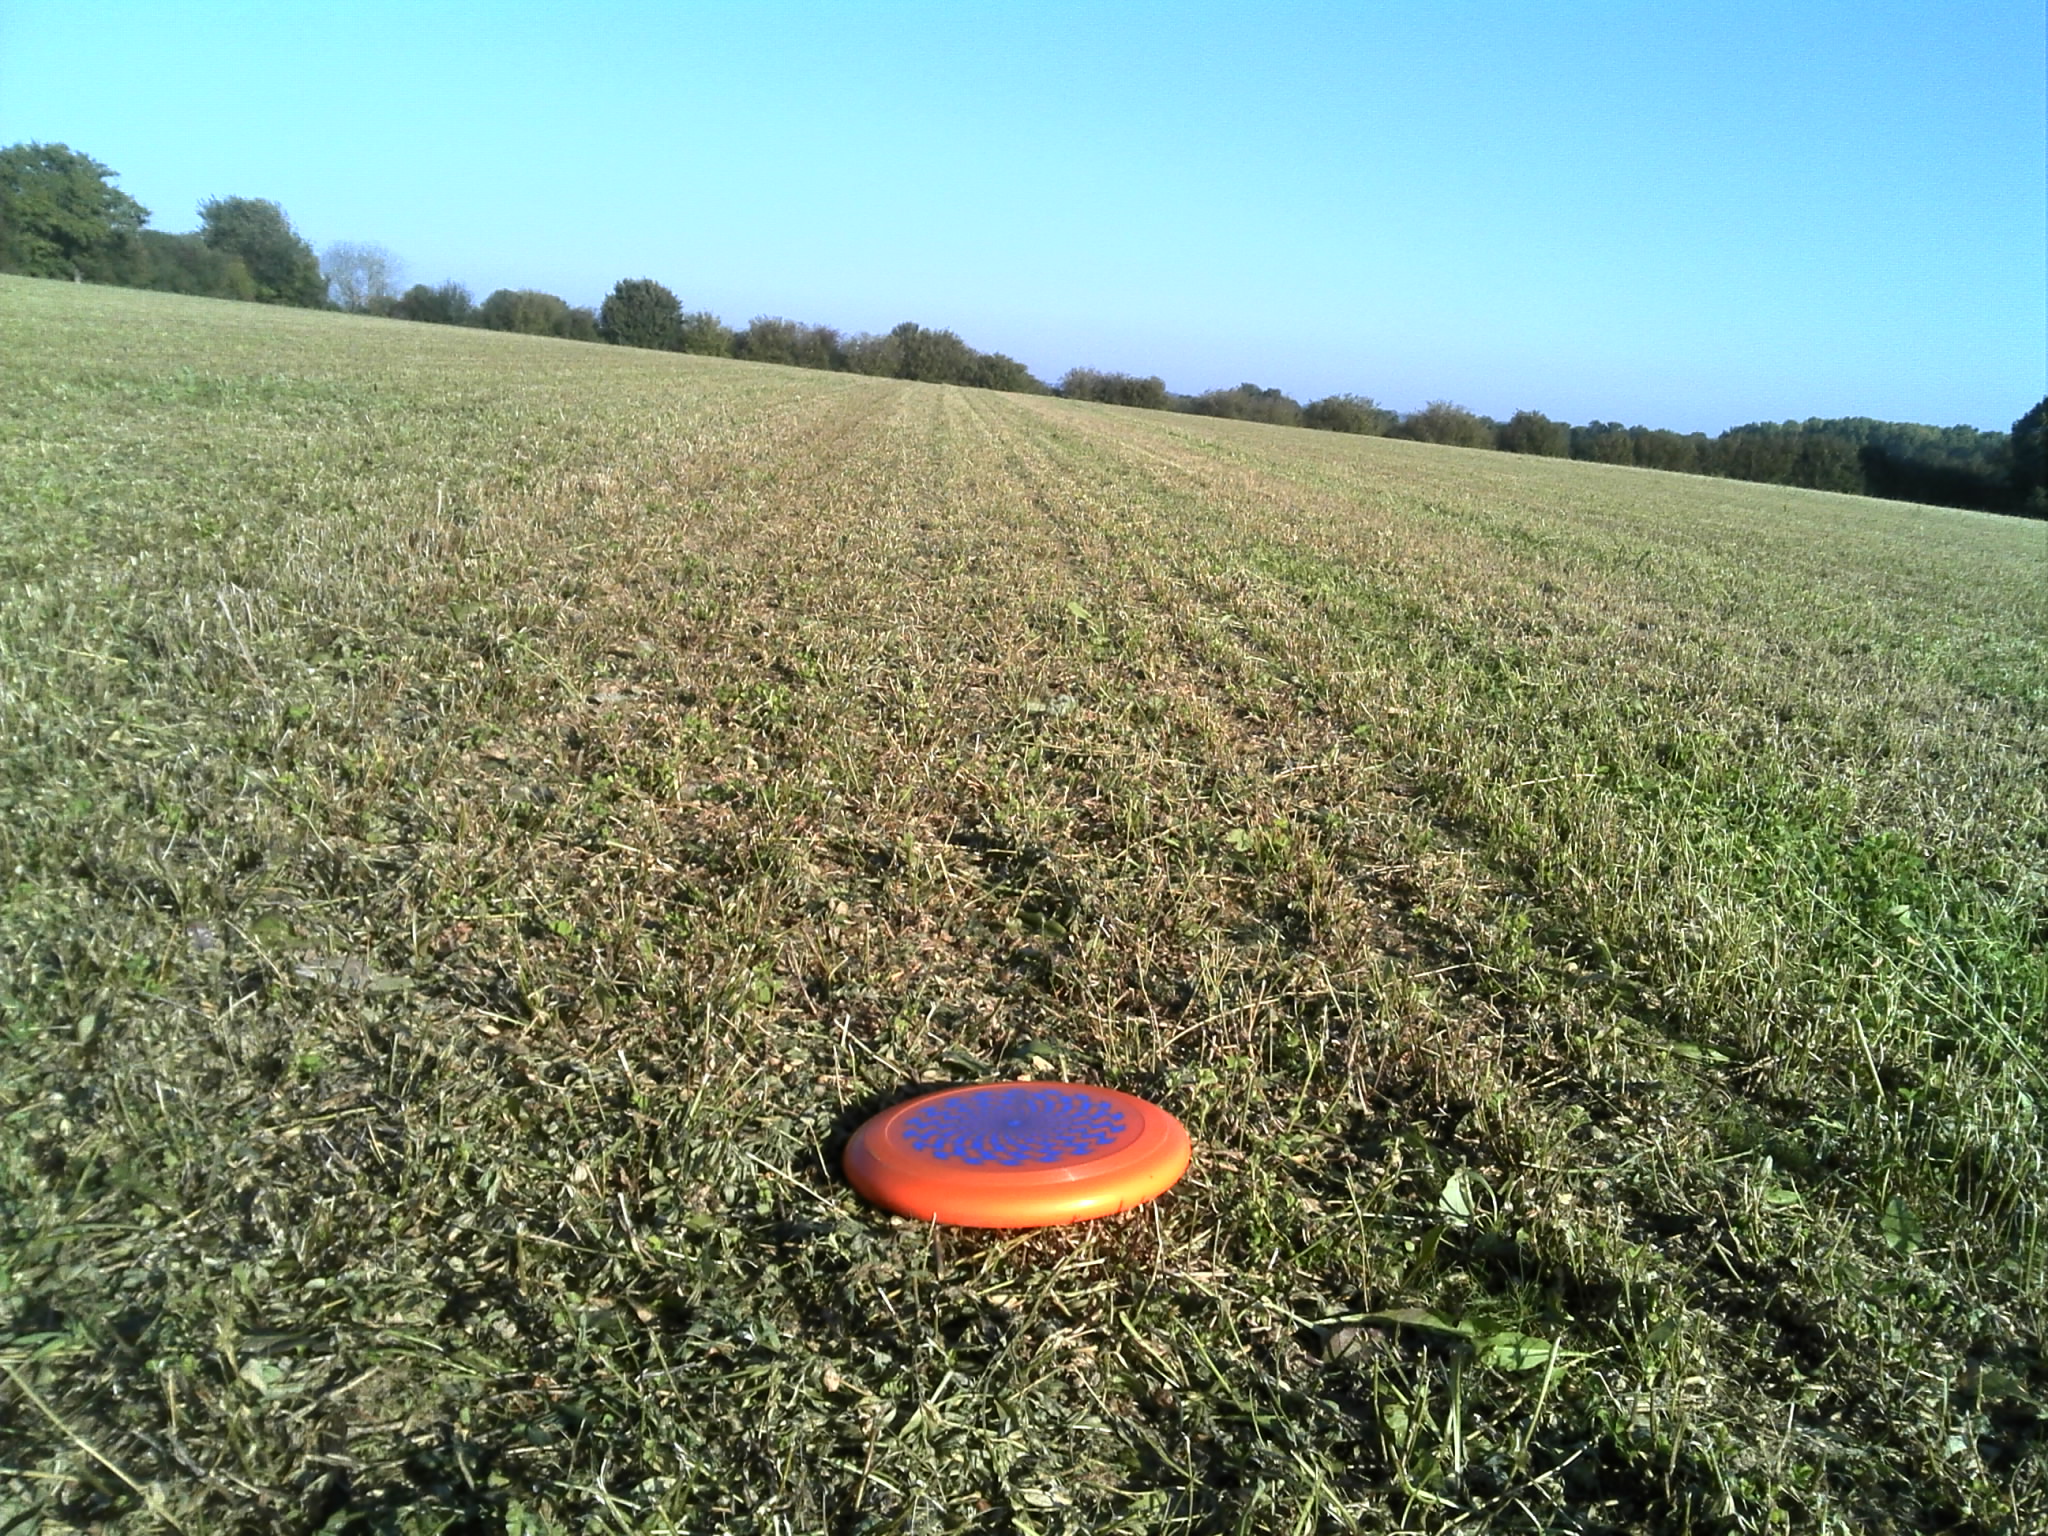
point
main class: Cropland
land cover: Temporary grasslands
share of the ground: > 75 %
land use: Agriculture (excluding fallow land and kitchen gardens)
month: October
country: FR
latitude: 47.6661
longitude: -1.0513
